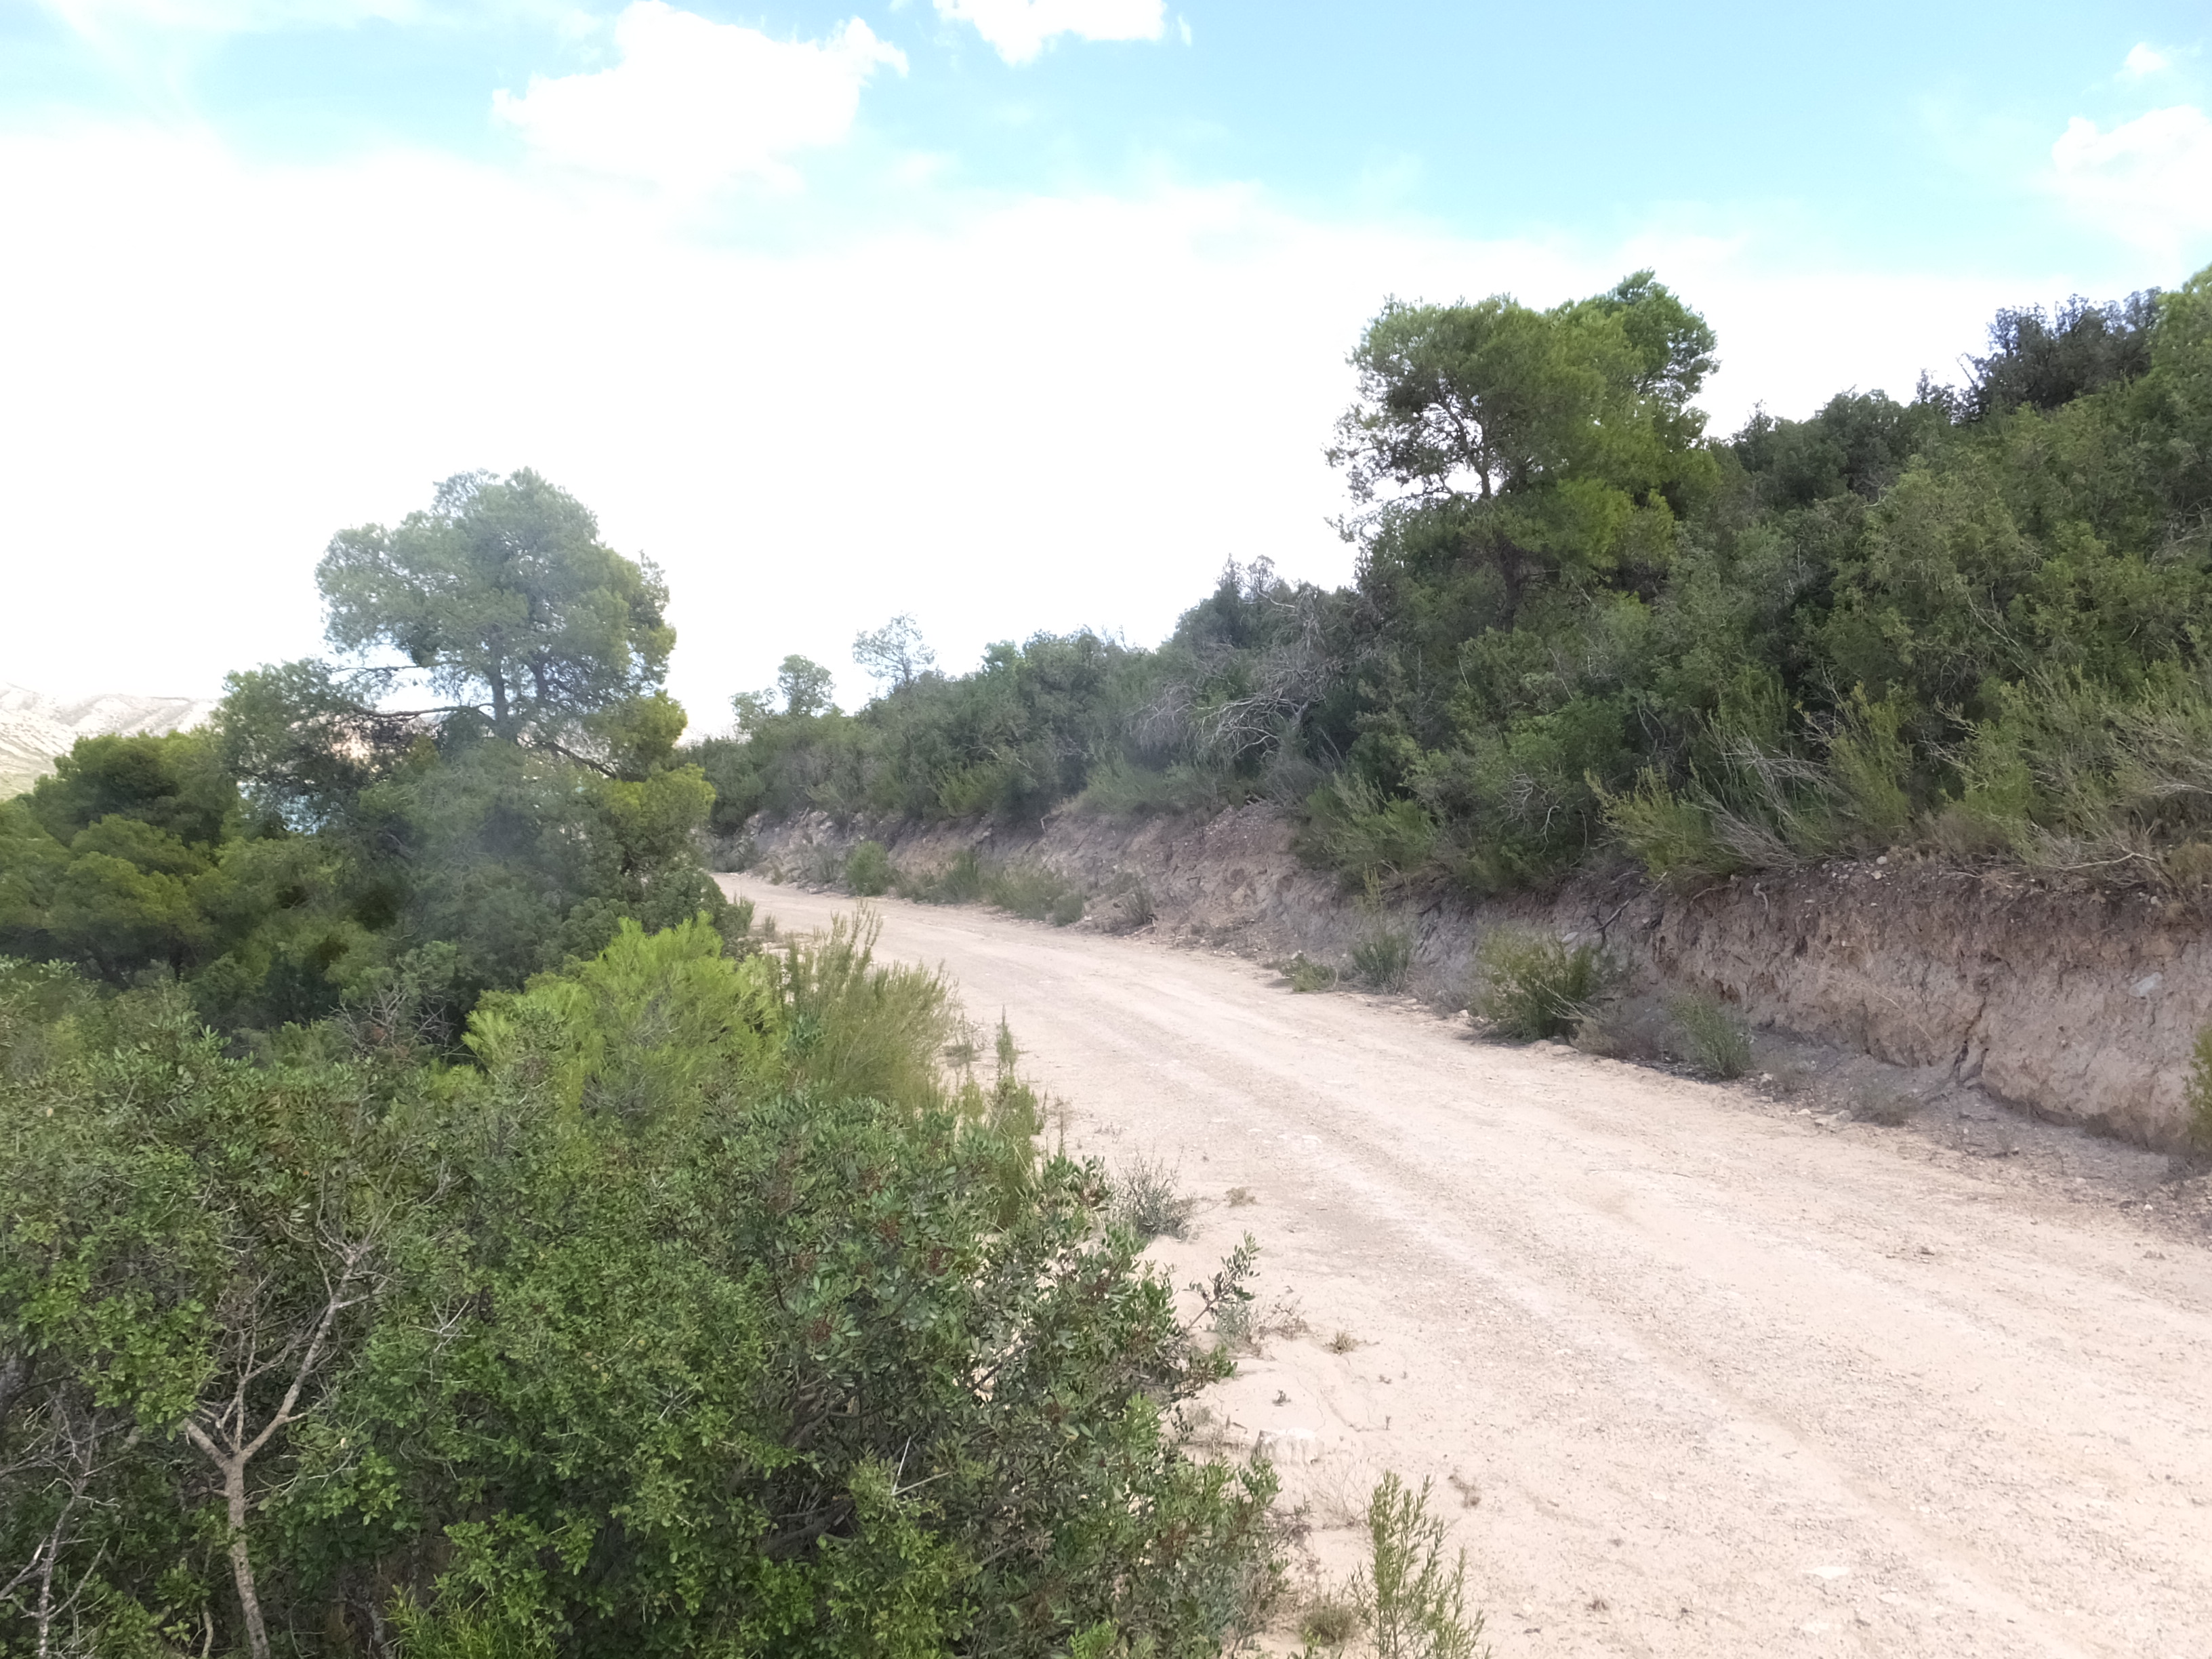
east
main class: Woodland
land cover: Pine dominated mixed woodland
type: coniferous forest of the mediterranean region
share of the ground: 50 - 75 %
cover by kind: coniferous forest trees 60 %, broadleaved forest trees 20 %, shrubs 10 %, herbaceous plants 10 %
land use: Forestry
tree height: > 5 m
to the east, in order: Pine dominated mixed woodland; Tracks; Pine dominated mixed woodland; Tracks; Pine dominated mixed woodland
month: August
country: ES
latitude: 41.3926
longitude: 0.1683
